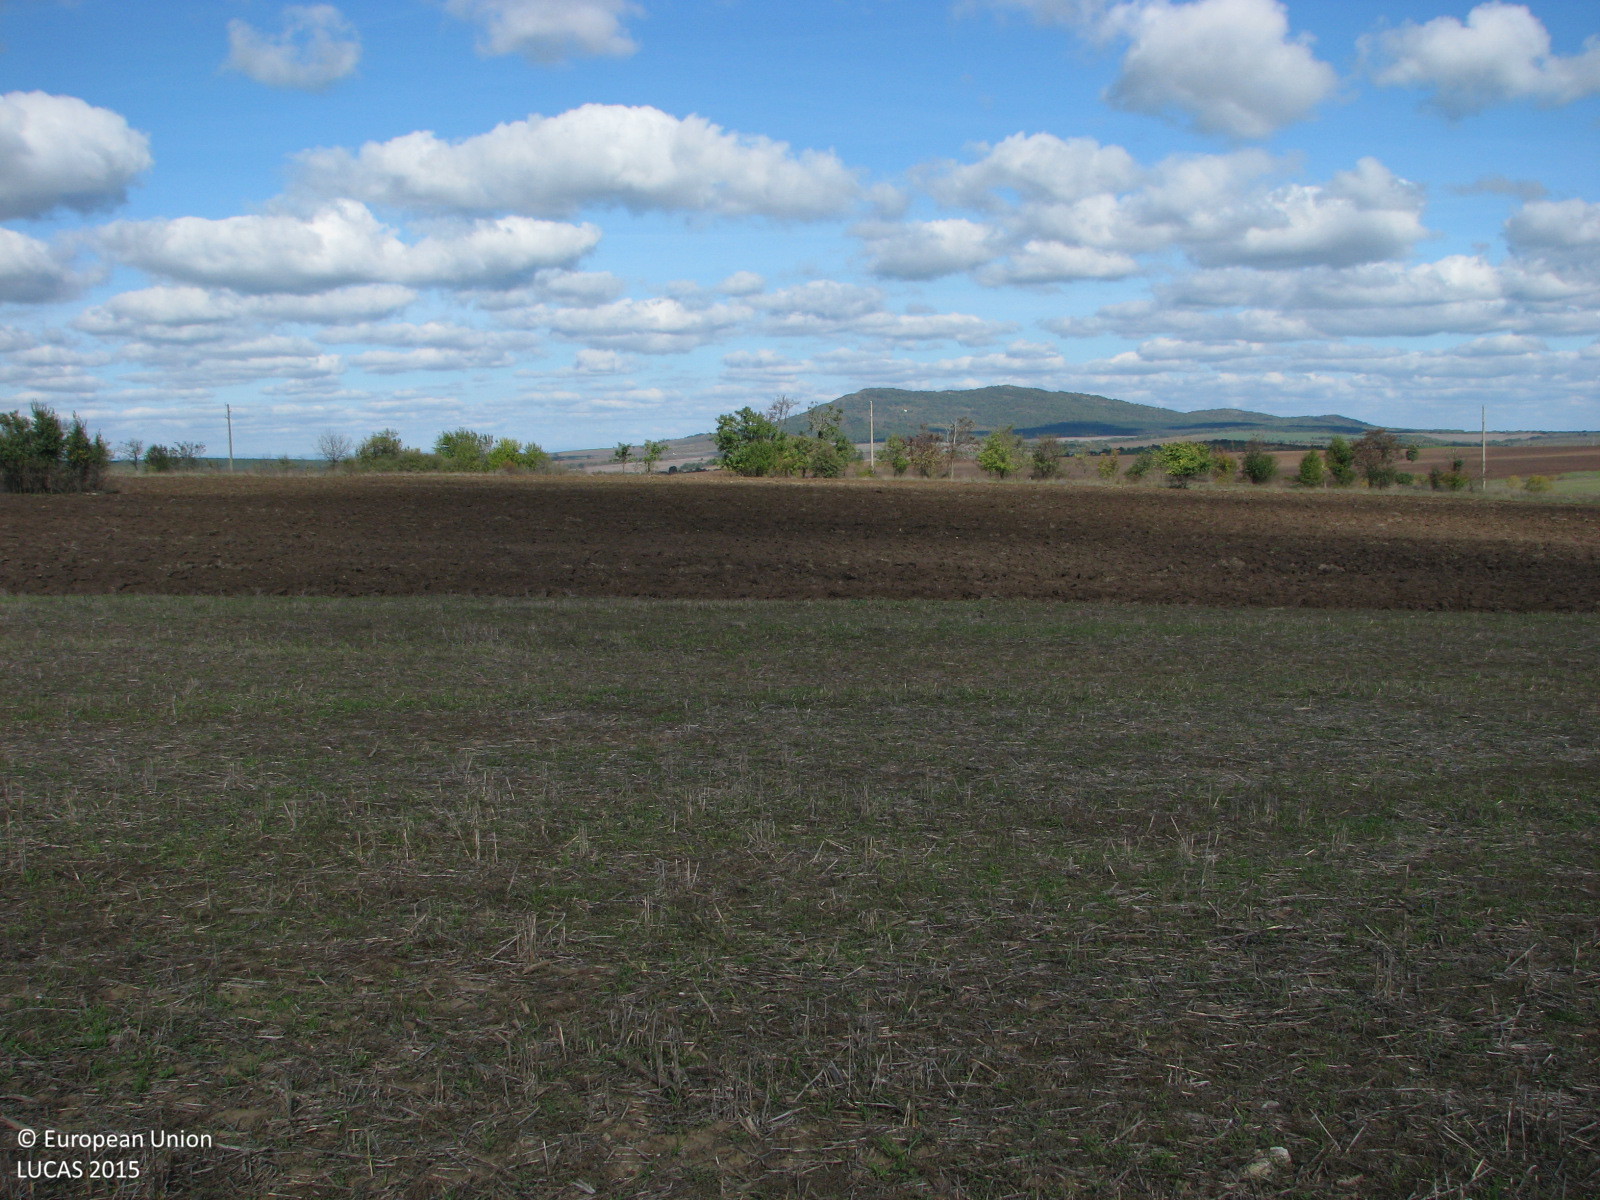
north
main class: Cropland
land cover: Common wheat
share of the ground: 25 - 50 %
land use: Agriculture (excluding fallow land and kitchen gardens)
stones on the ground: < 10 %
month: October
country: BG
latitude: 42.3062
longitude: 26.8016
